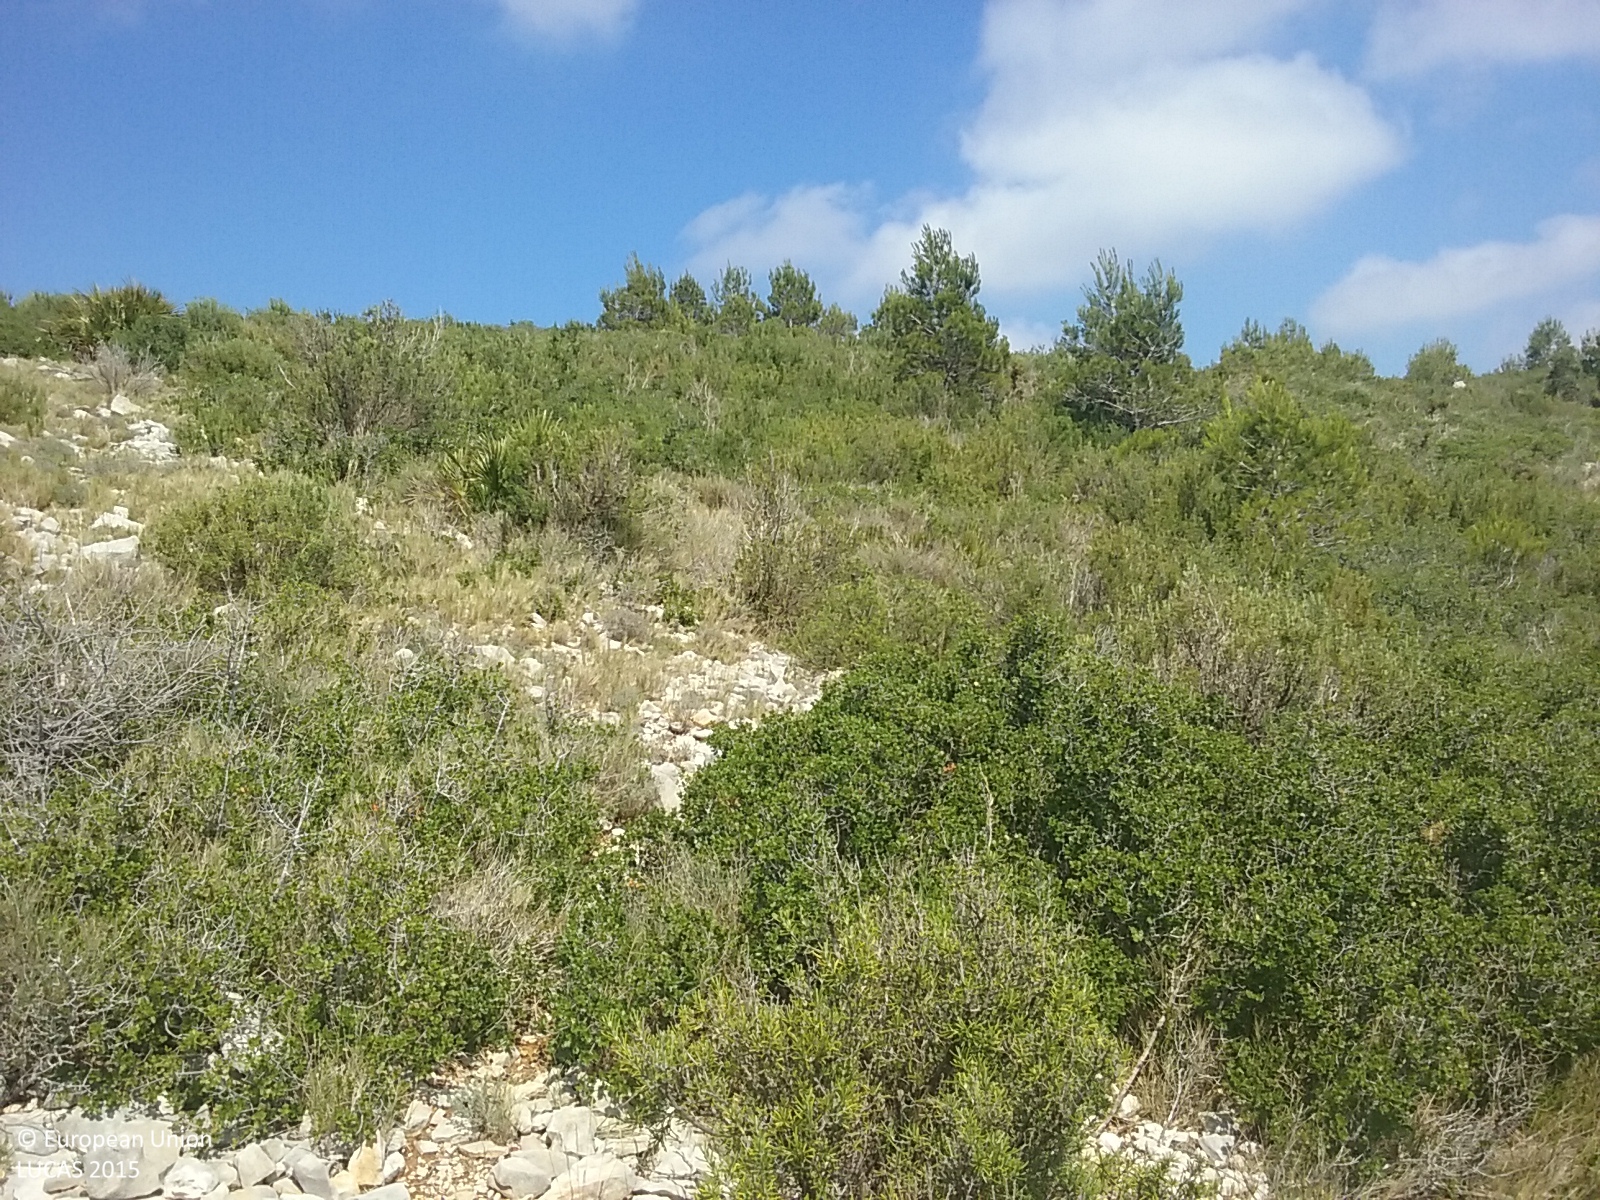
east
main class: Shrubland
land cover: Shrubland with sparse tree cover
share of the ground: > 75 %
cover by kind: shrubs 80 %, herbaceous plants 10 %, coniferous forest trees 5 %, unconsolidated bare surface 5 %
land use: Semi-natural and natural areas not in use
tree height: < 5 m
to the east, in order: Shrubland with sparse tree cover; Pine dominated coniferous woodland; Shrubland with sparse tree cover
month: June
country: ES
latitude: 40.8938
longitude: 0.6524
